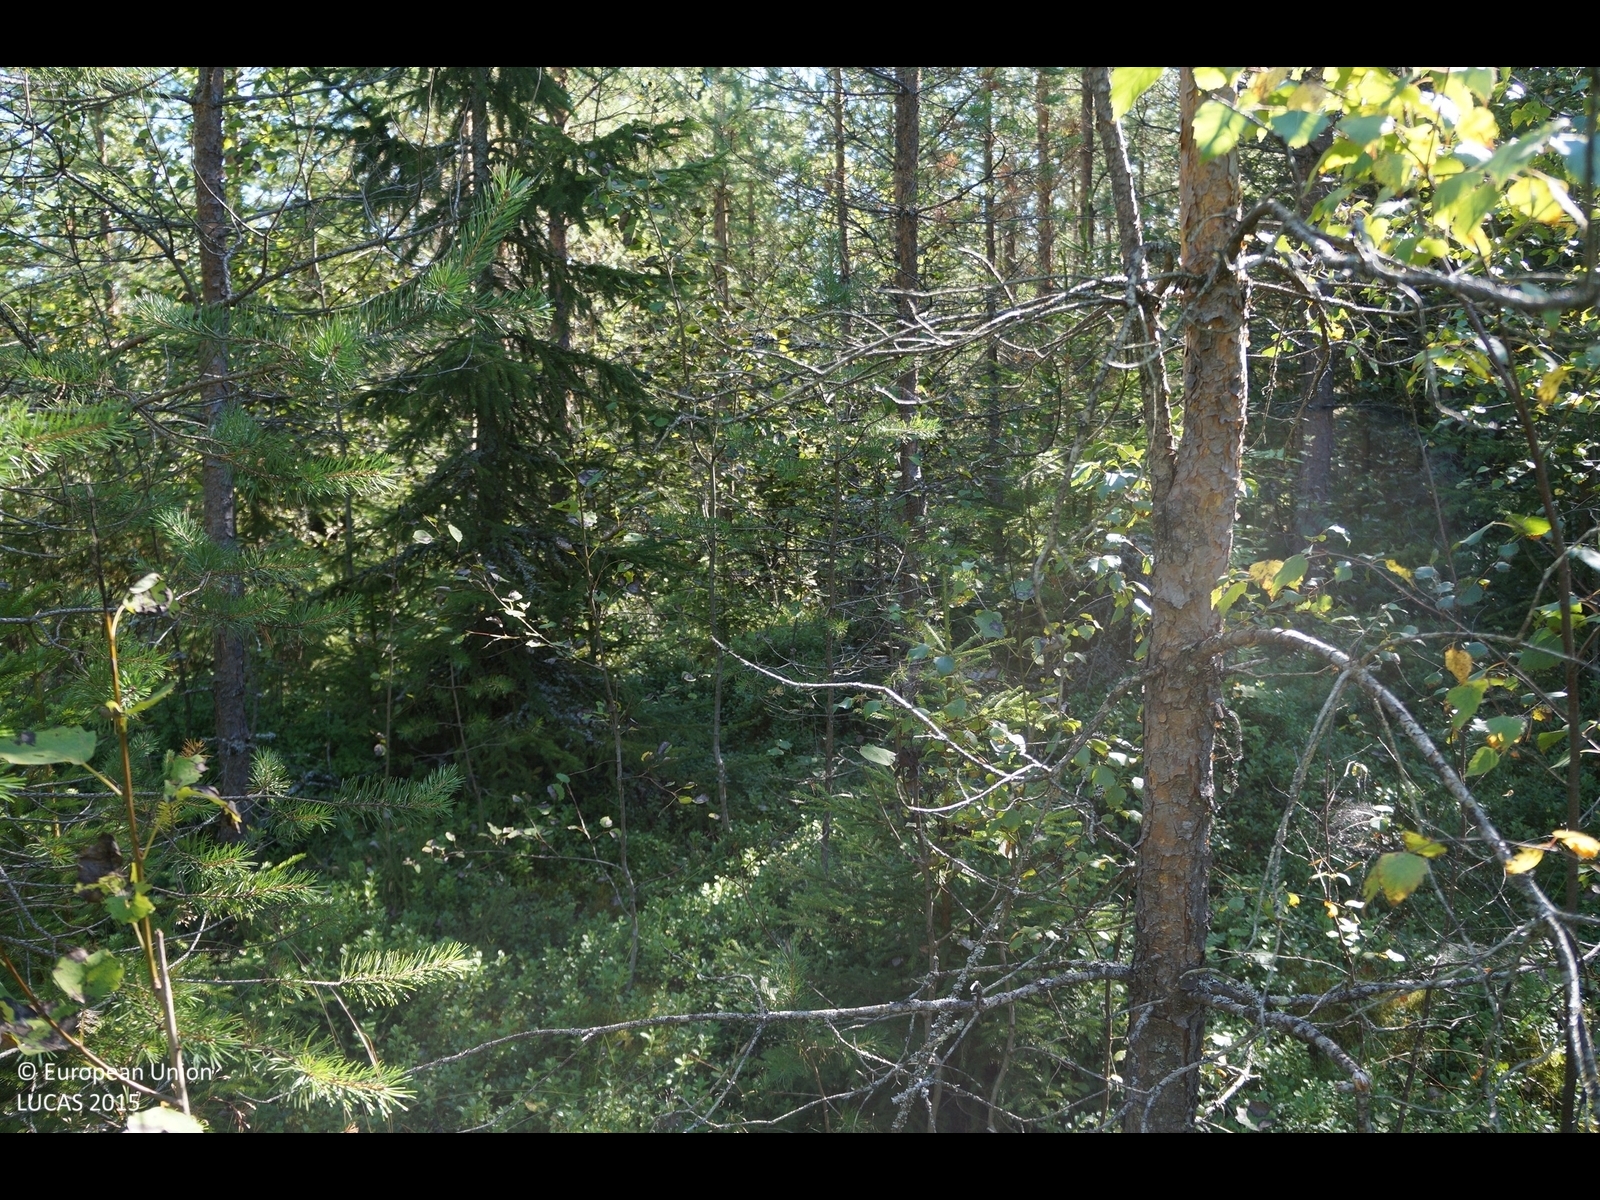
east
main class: Woodland
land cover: Other mixed woodland
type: boreal forest
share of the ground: 50 - 75 %
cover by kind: coniferous forest trees 50 %, shrubs 30 %, broadleaved forest trees 20 %
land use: Forestry
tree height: > 5 m
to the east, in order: Other mixed woodland; Ditches and canals; Abandoned hedges; Tracks; Other mixed woodland; Pine dominated coniferous woodland; Pine dominated mixed woodland; Other mixed woodland; Broadleaved woodland; Ditches and canals; Temporary grasslands; Ditches and canals; Pine dominated mixed woodland
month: August
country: FI
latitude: 63.7362
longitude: 22.9539
